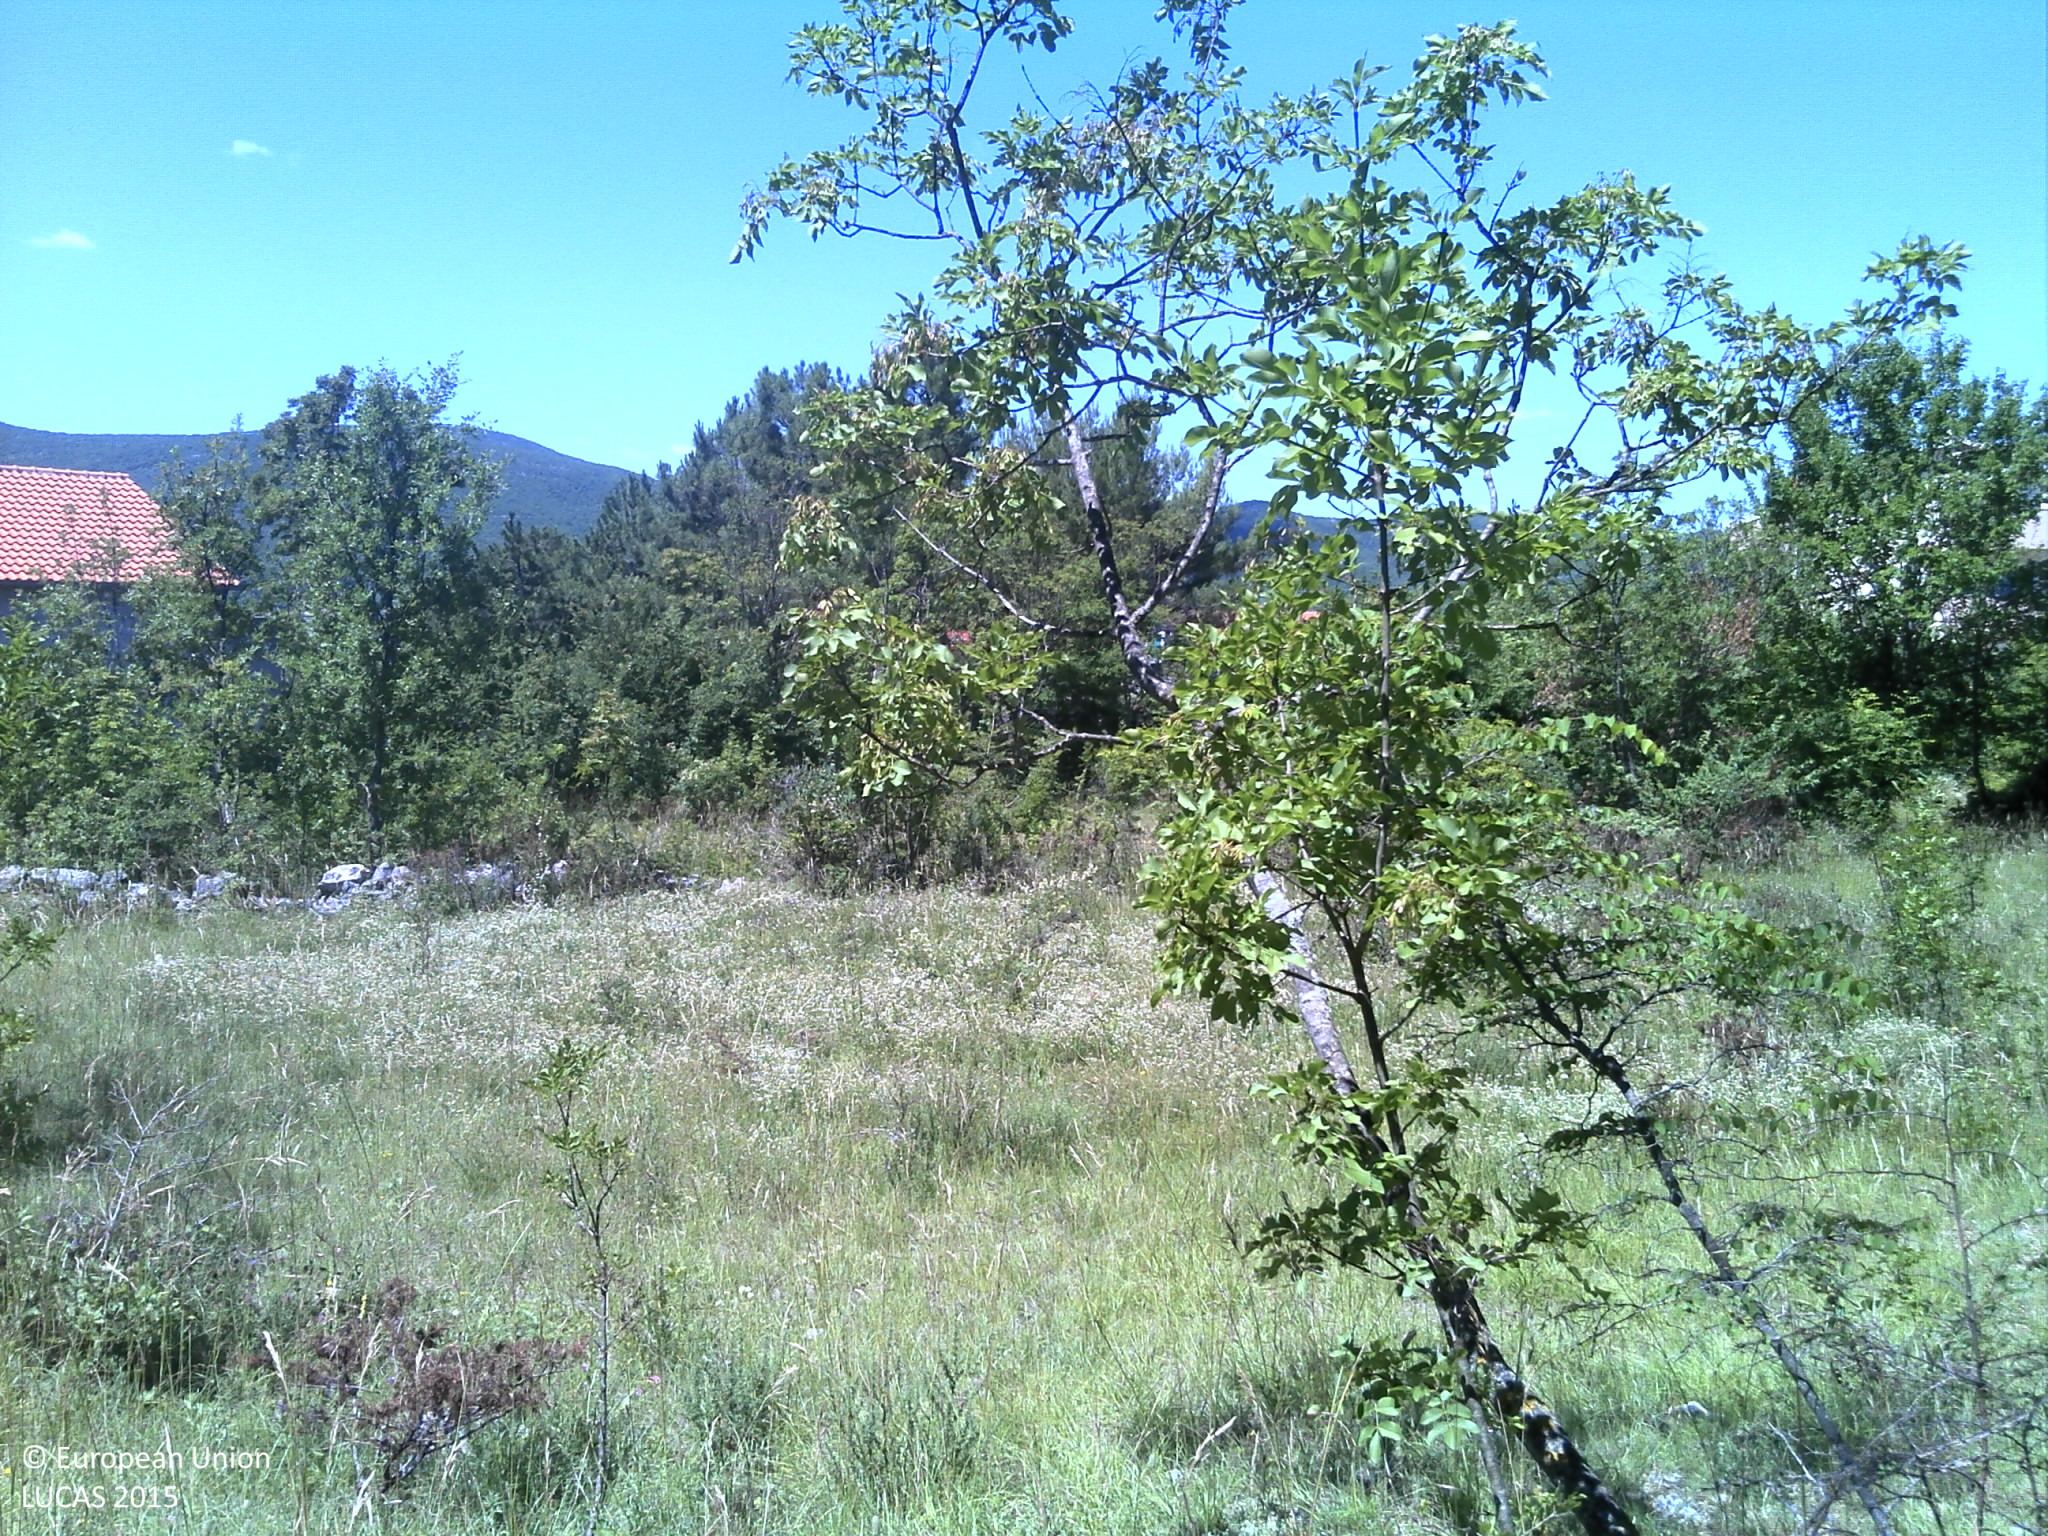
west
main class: Grassland
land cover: Grassland with sparse tree/shrub cover
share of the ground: > 75 %
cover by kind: herbaceous plants 80 %, shrubs 10 %, broadleaved forest trees 5 %, unconsolidated bare surface 5 %
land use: Agriculture (excluding fallow land and kitchen gardens)
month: June
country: HR
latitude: 43.6338
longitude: 16.5980
